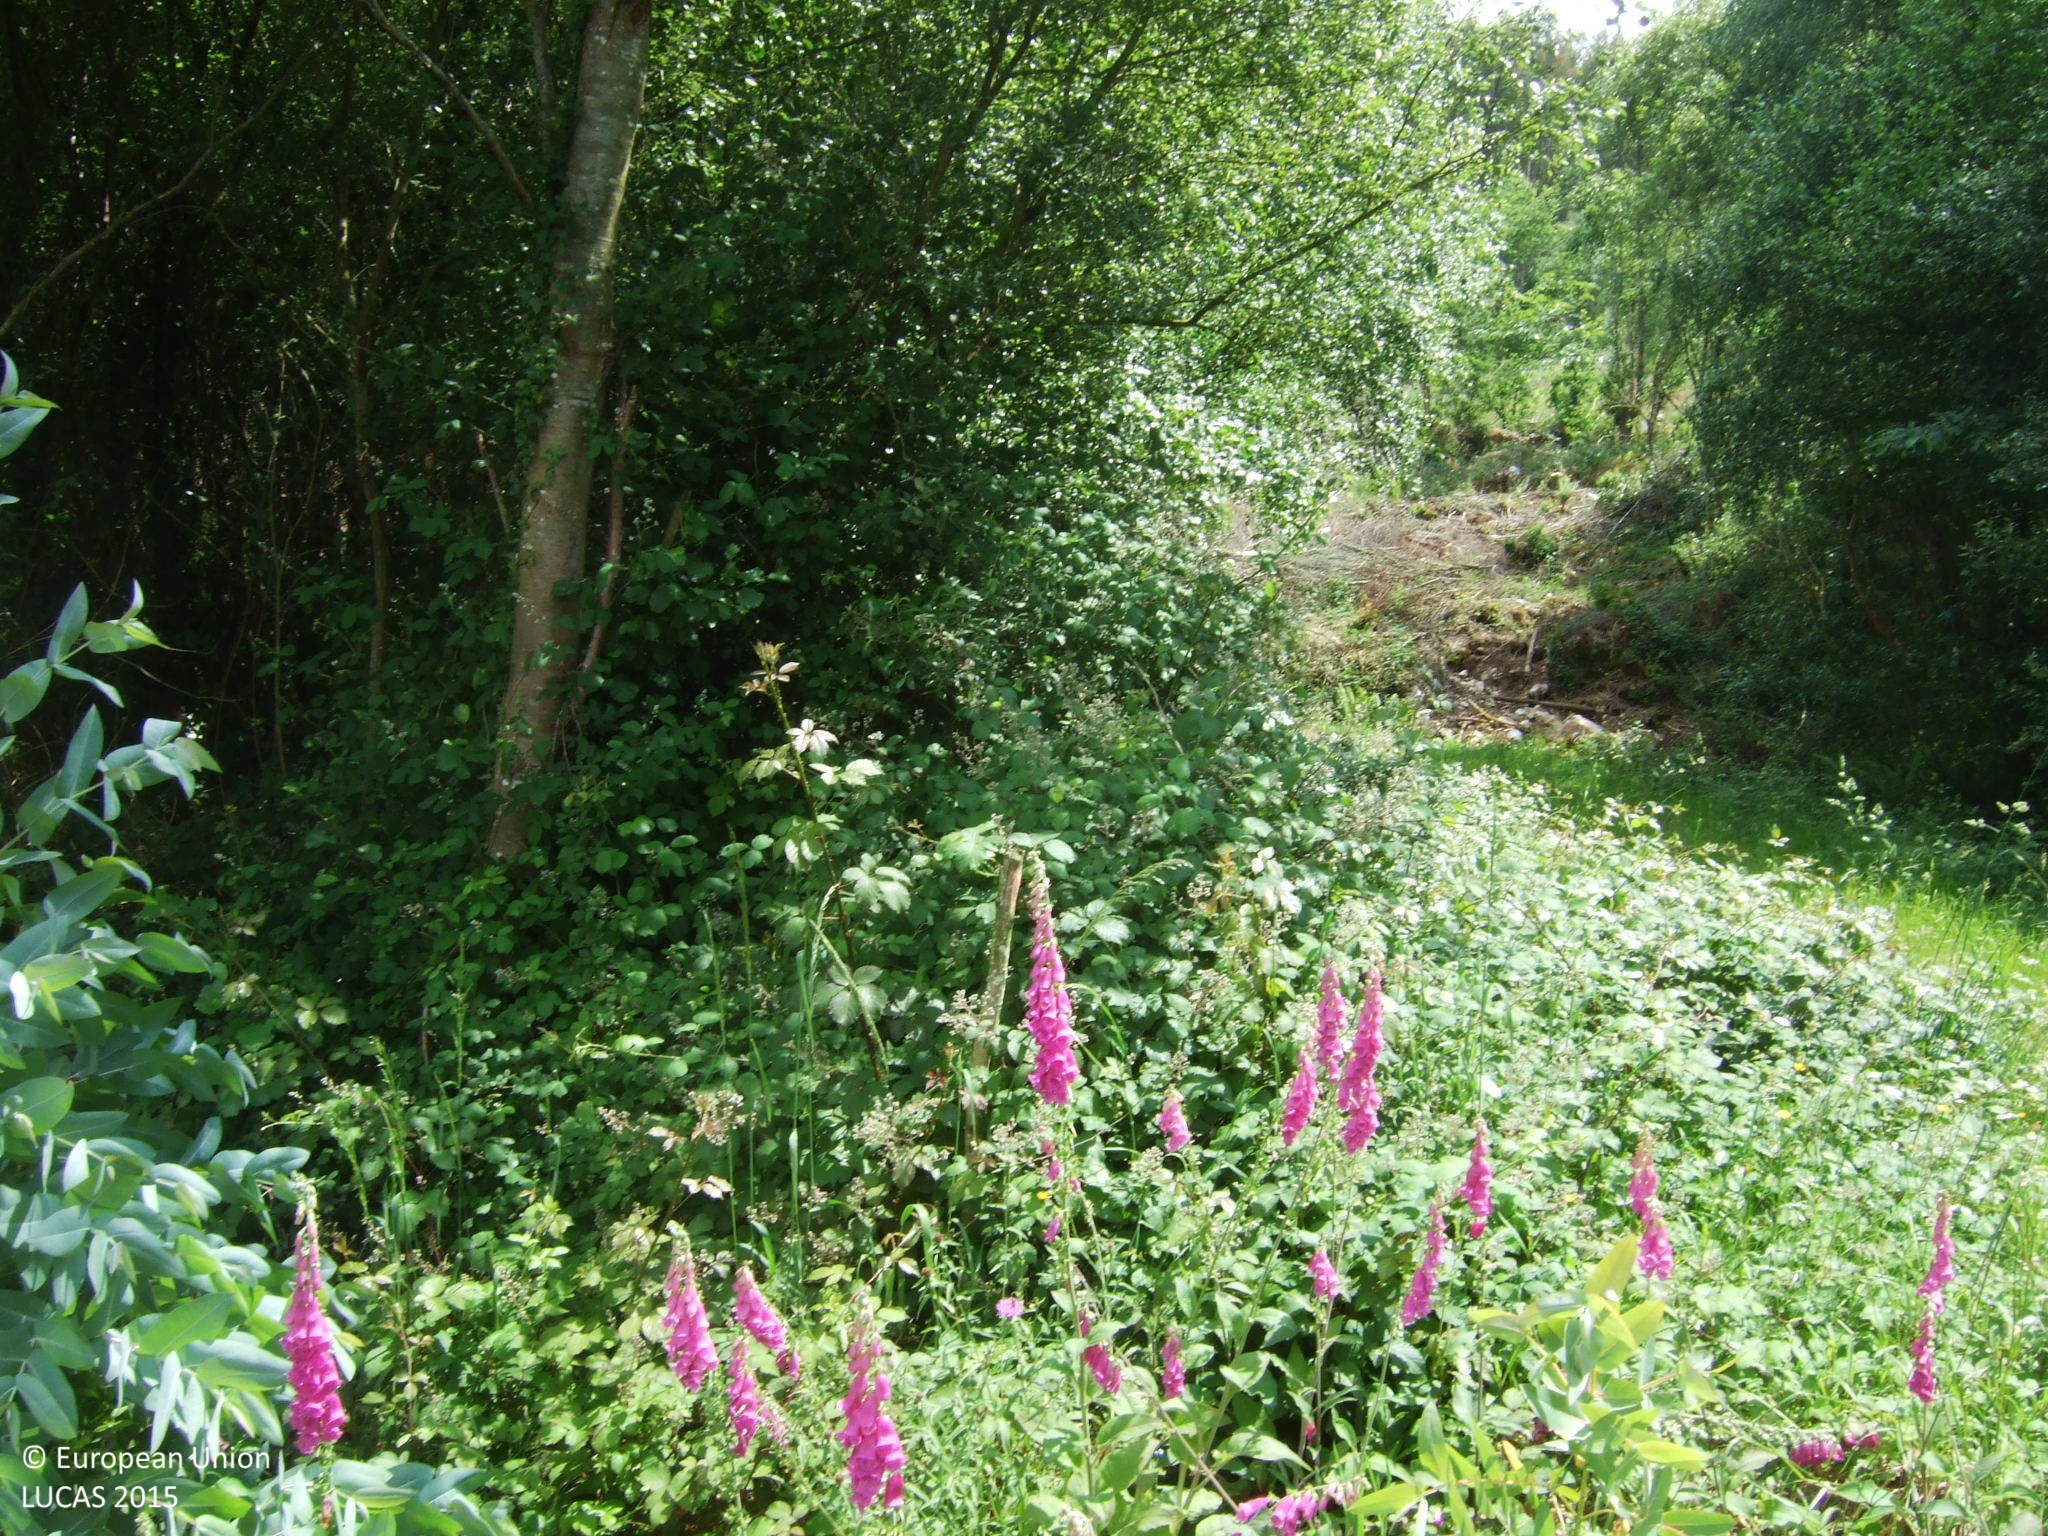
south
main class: Woodland
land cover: Broadleaved woodland
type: exotic forest
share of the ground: 25 - 50 %
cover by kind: shrubs 65 %, broadleaved forest trees 35 %
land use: Forestry
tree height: < 5 m
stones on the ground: 25 - 50 %
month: June
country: ES
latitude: 43.3163
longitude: -7.2484
